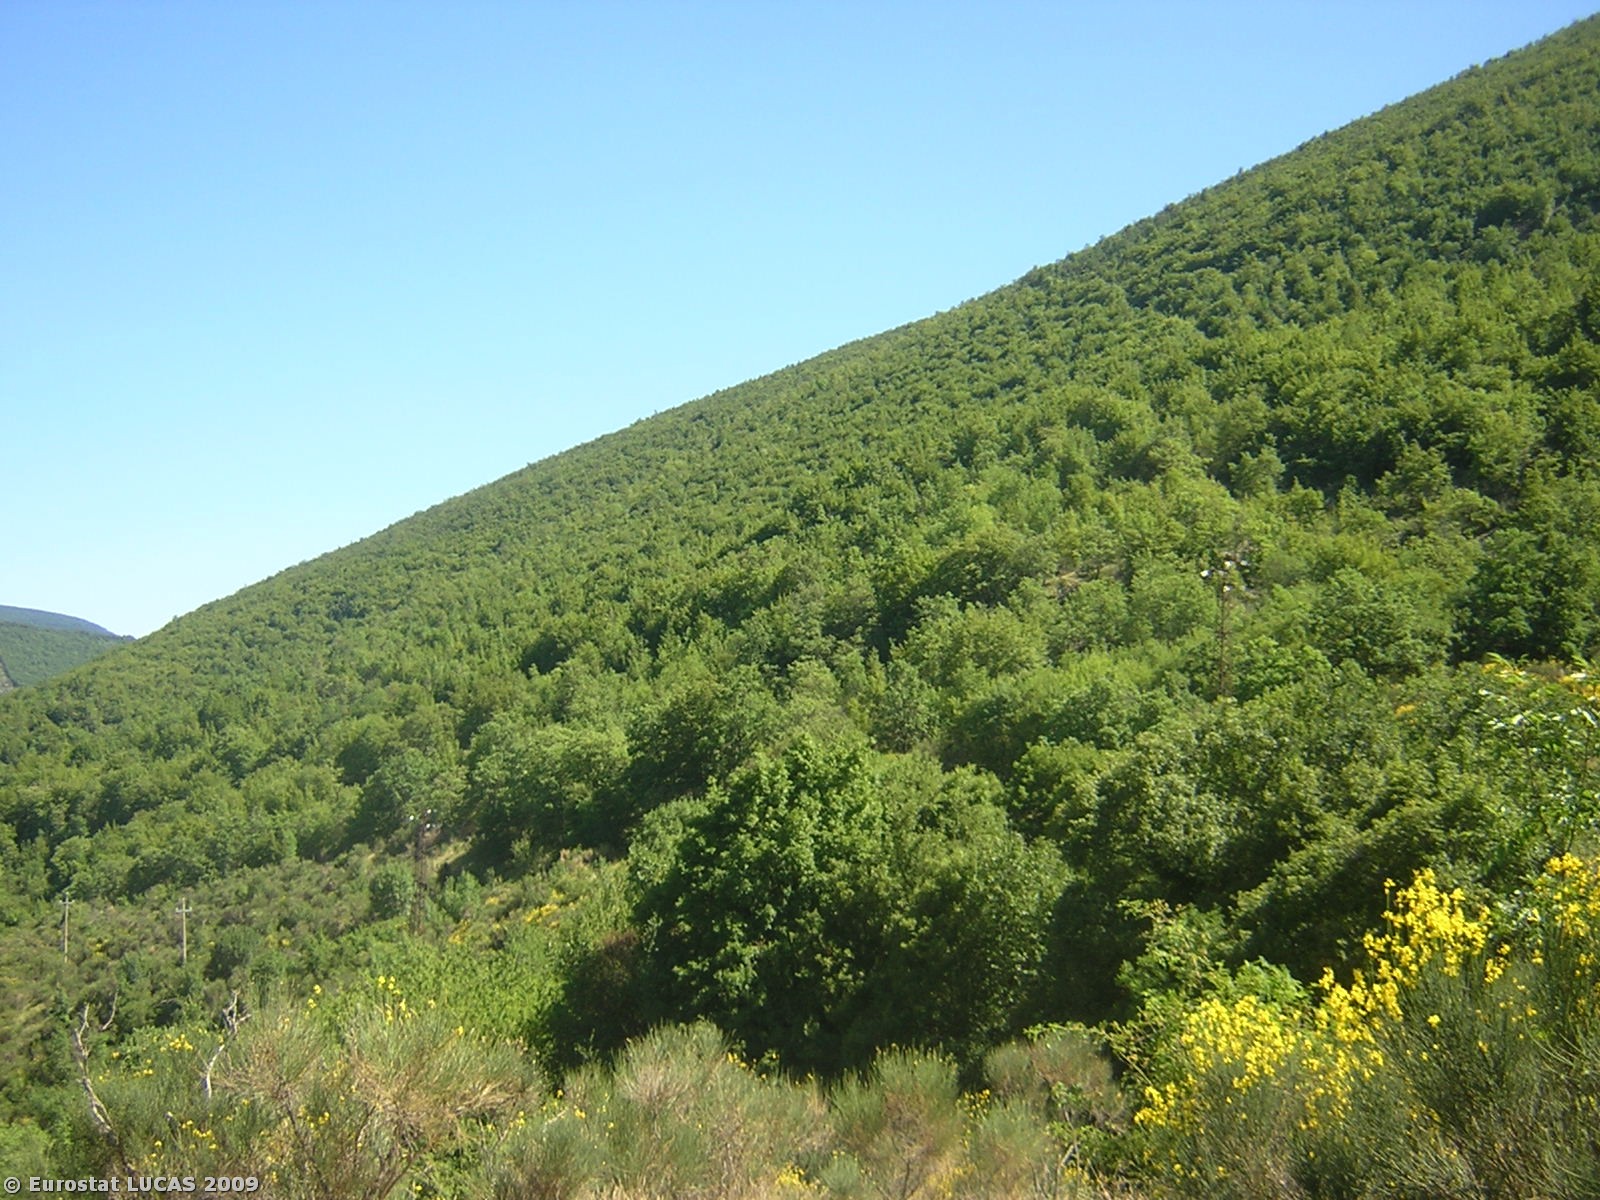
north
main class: Shrubland
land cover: Shrubland with sparse tree cover
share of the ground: > 75 %
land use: Unused
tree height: > 5 m
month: July
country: IT
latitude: 43.1551
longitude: 12.8819
